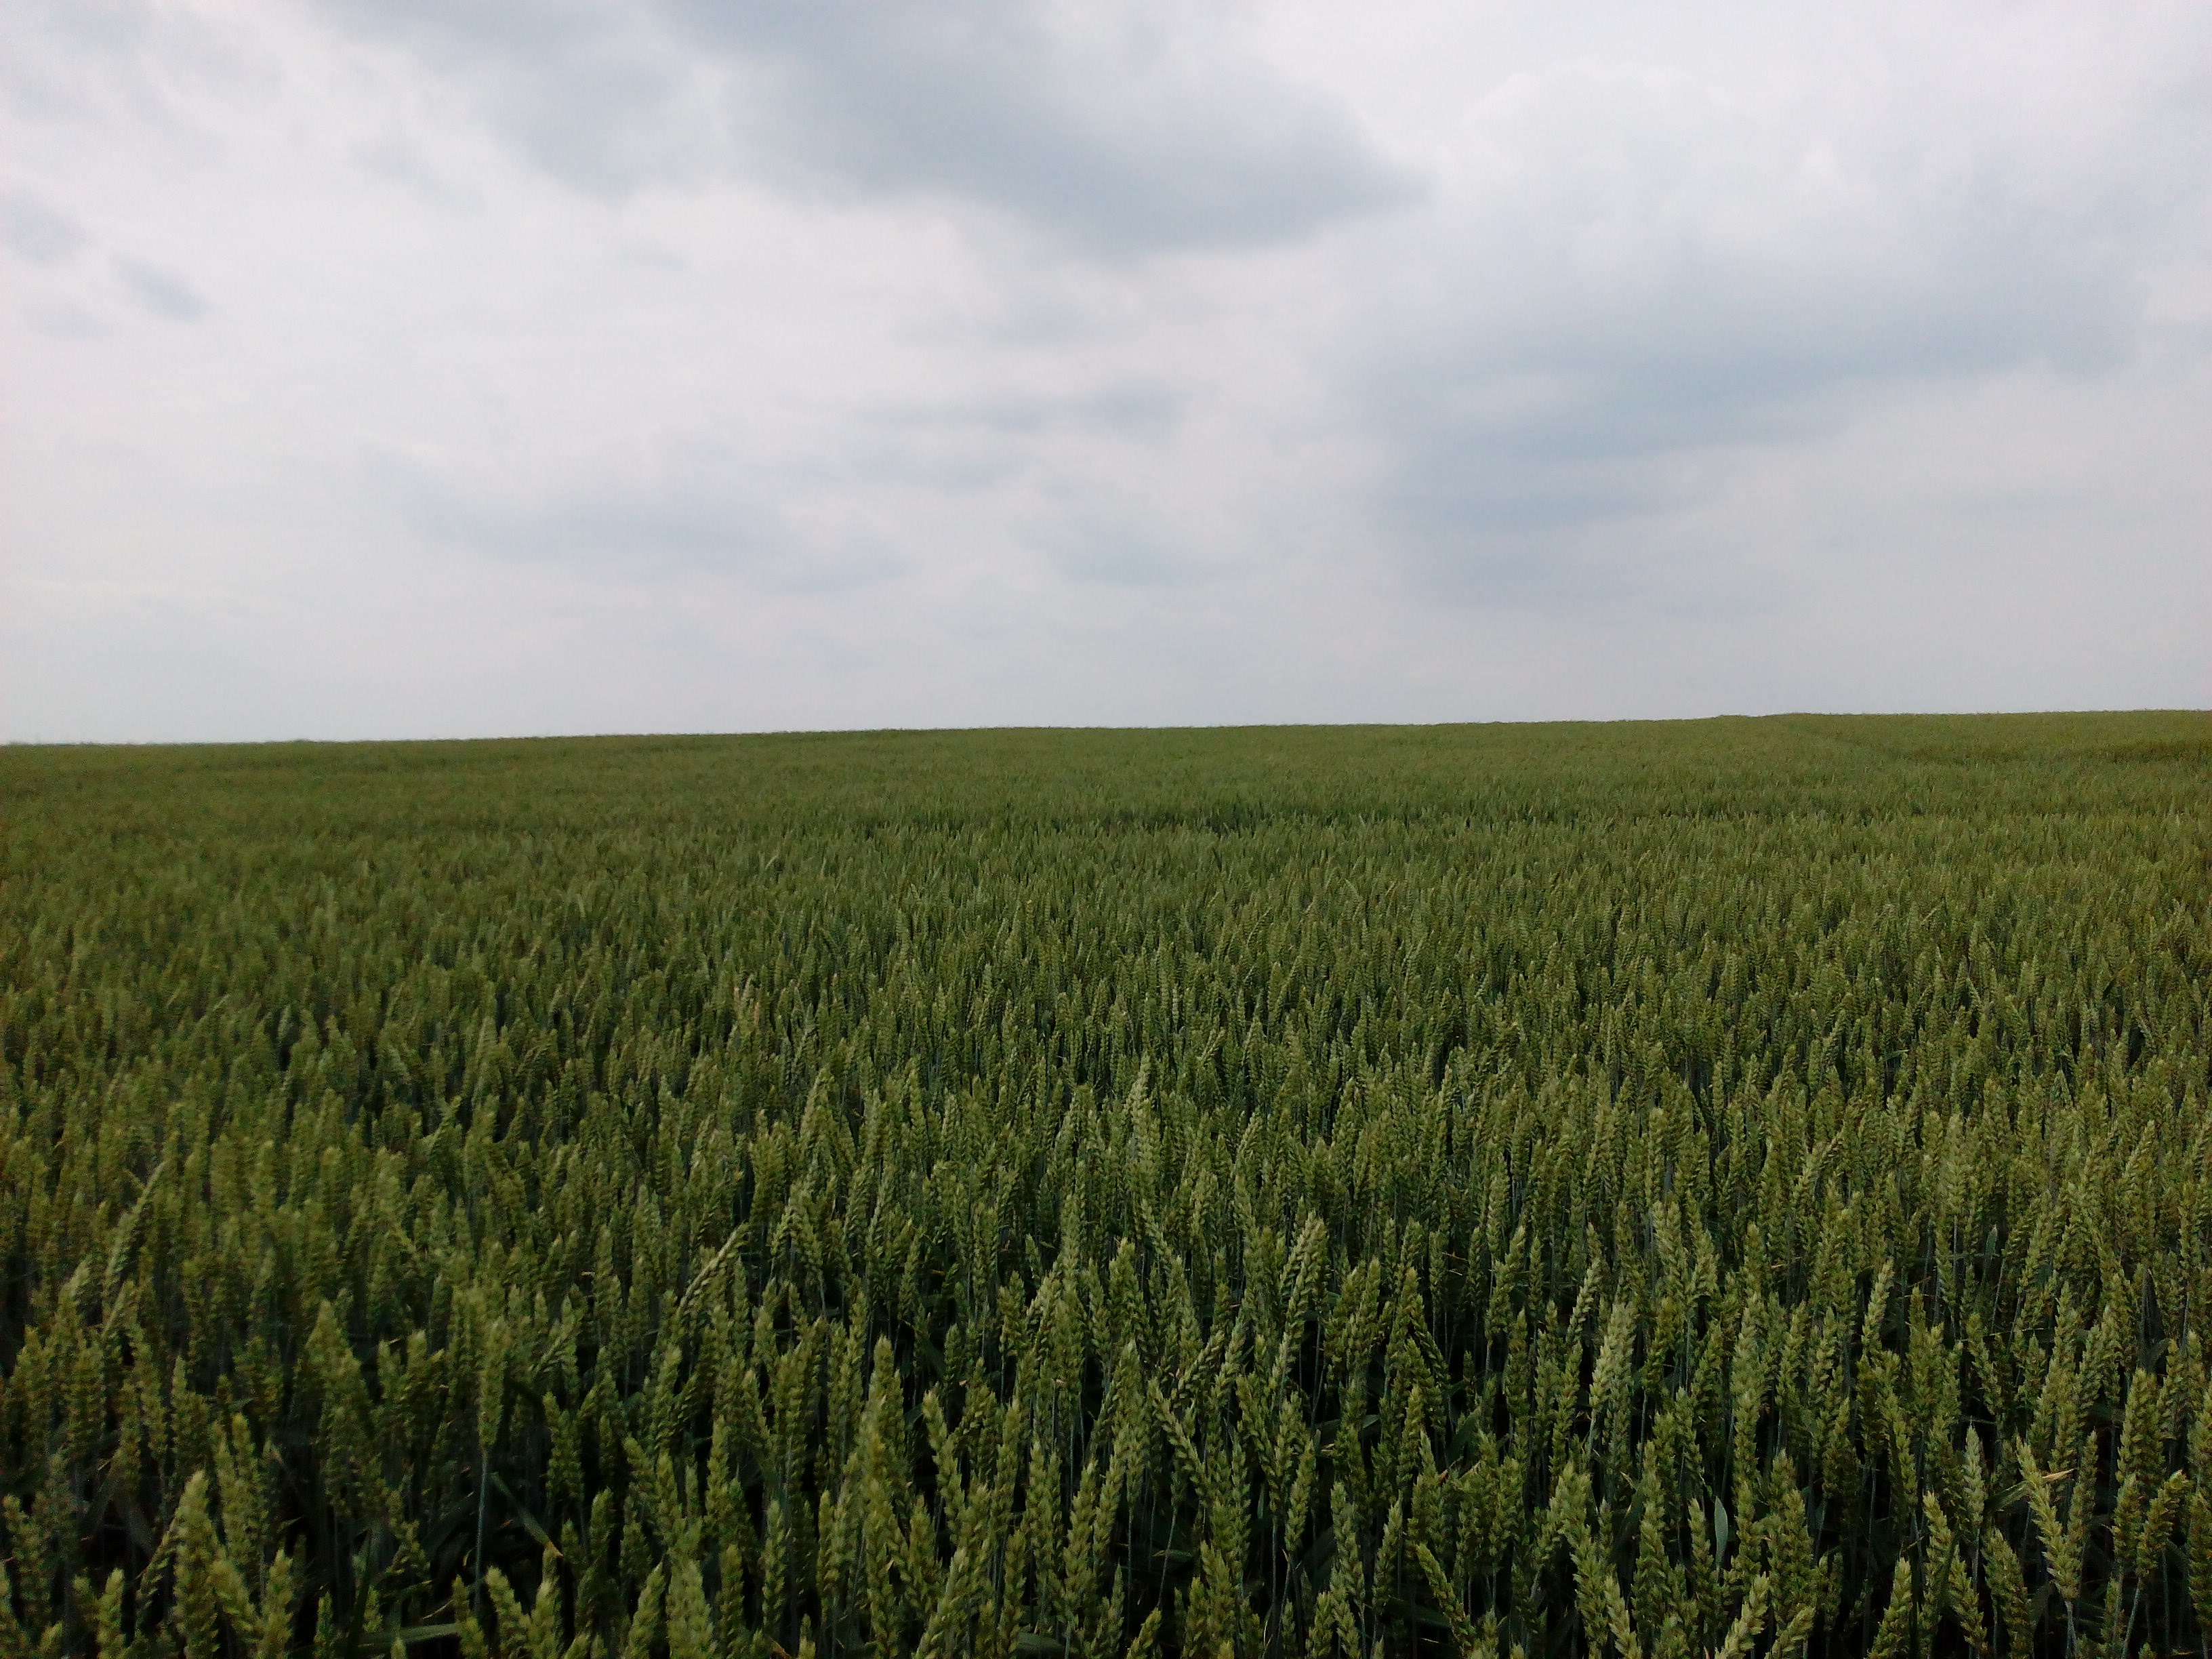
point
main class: Cropland
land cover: Common wheat
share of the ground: > 75 %
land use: Agriculture (excluding fallow land and kitchen gardens)
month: June
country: DE
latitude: 51.2757
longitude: 11.1035
